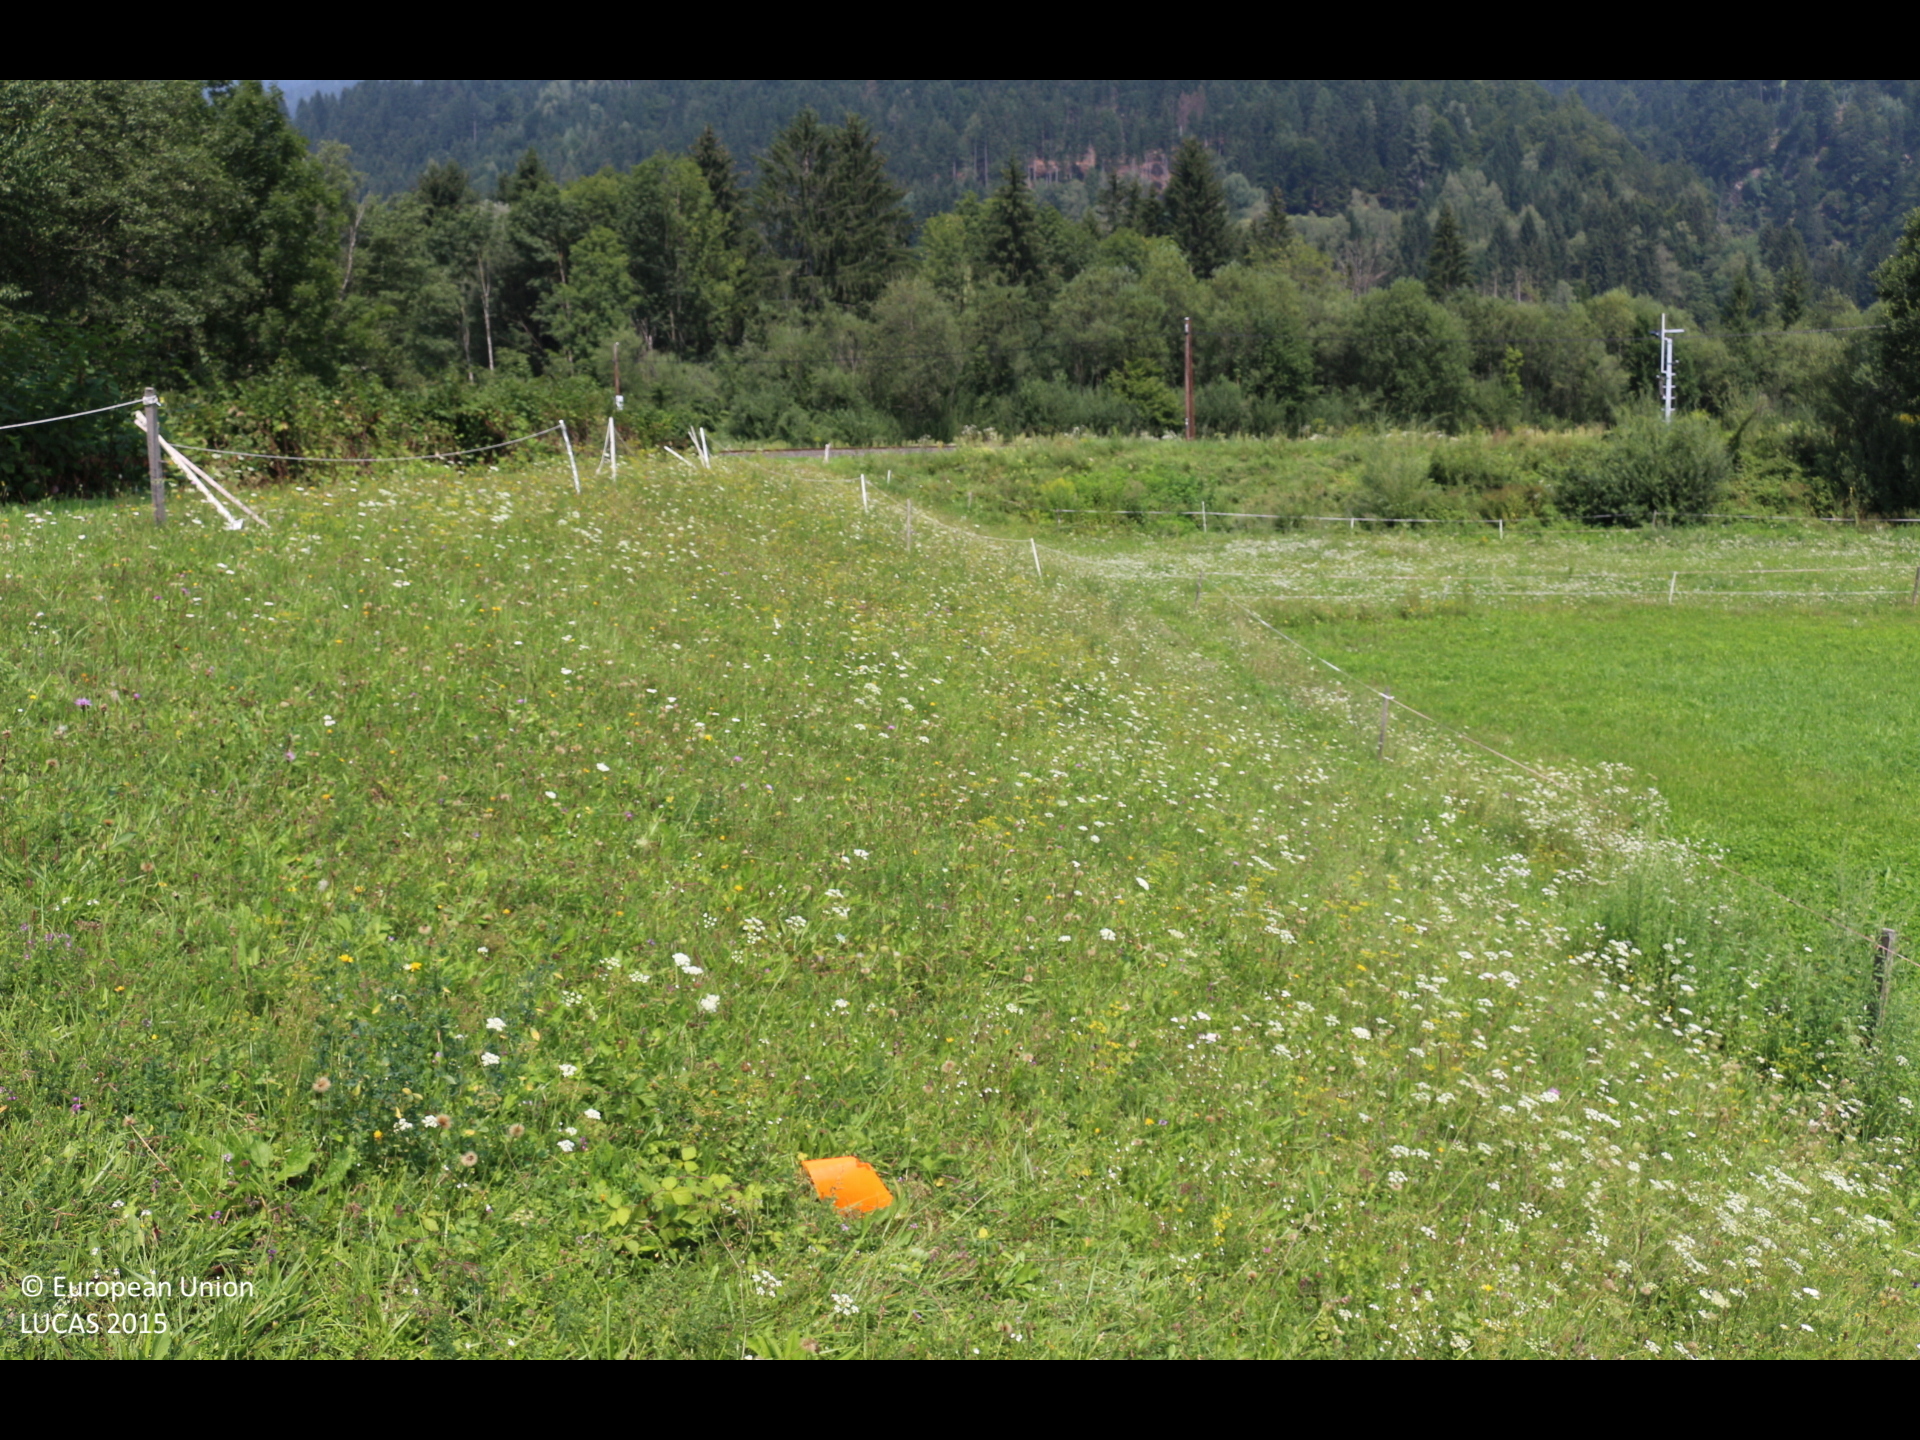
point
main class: Grassland
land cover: Grassland without tree/shrub cover
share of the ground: > 75 %
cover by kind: herbaceous plants 100 %
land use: Agriculture (excluding fallow land and kitchen gardens)
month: August
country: AT
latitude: 46.6263
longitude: 13.2492
